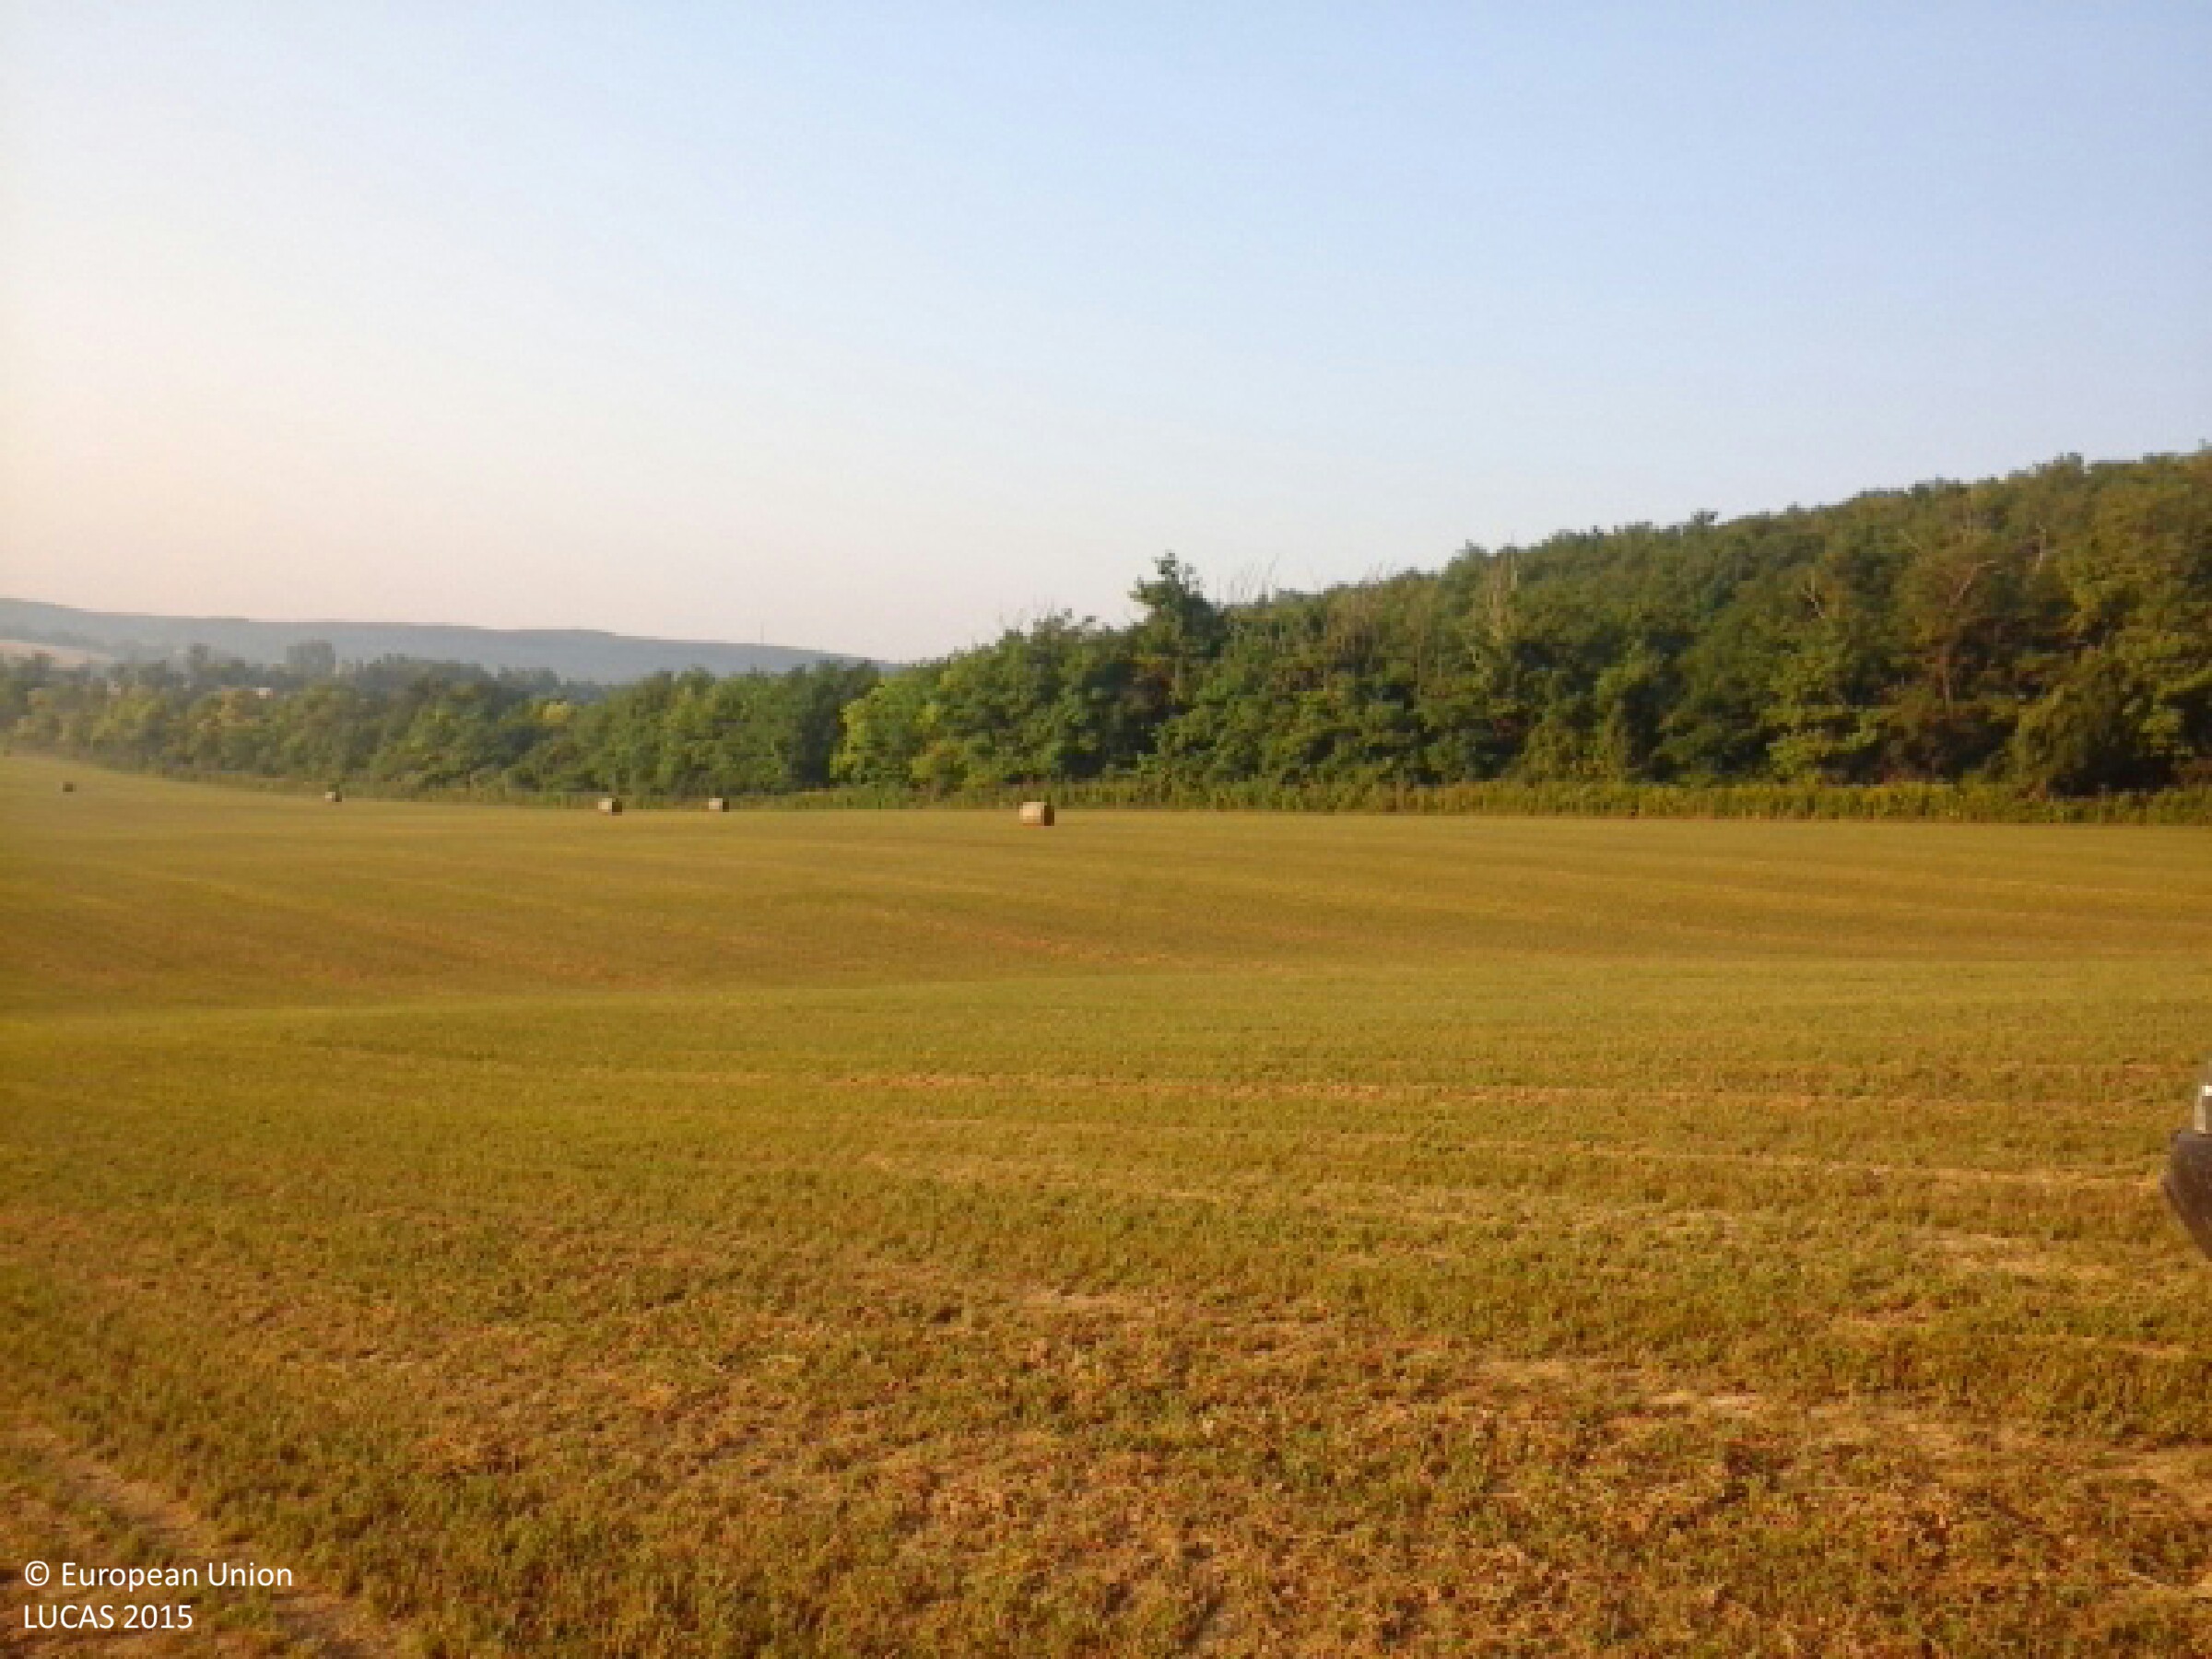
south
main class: Cropland
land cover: Lucerne
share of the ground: 50 - 75 %
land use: Agriculture (excluding fallow land and kitchen gardens)
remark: Harvested field
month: August
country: HU
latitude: 47.5465
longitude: 18.5579
